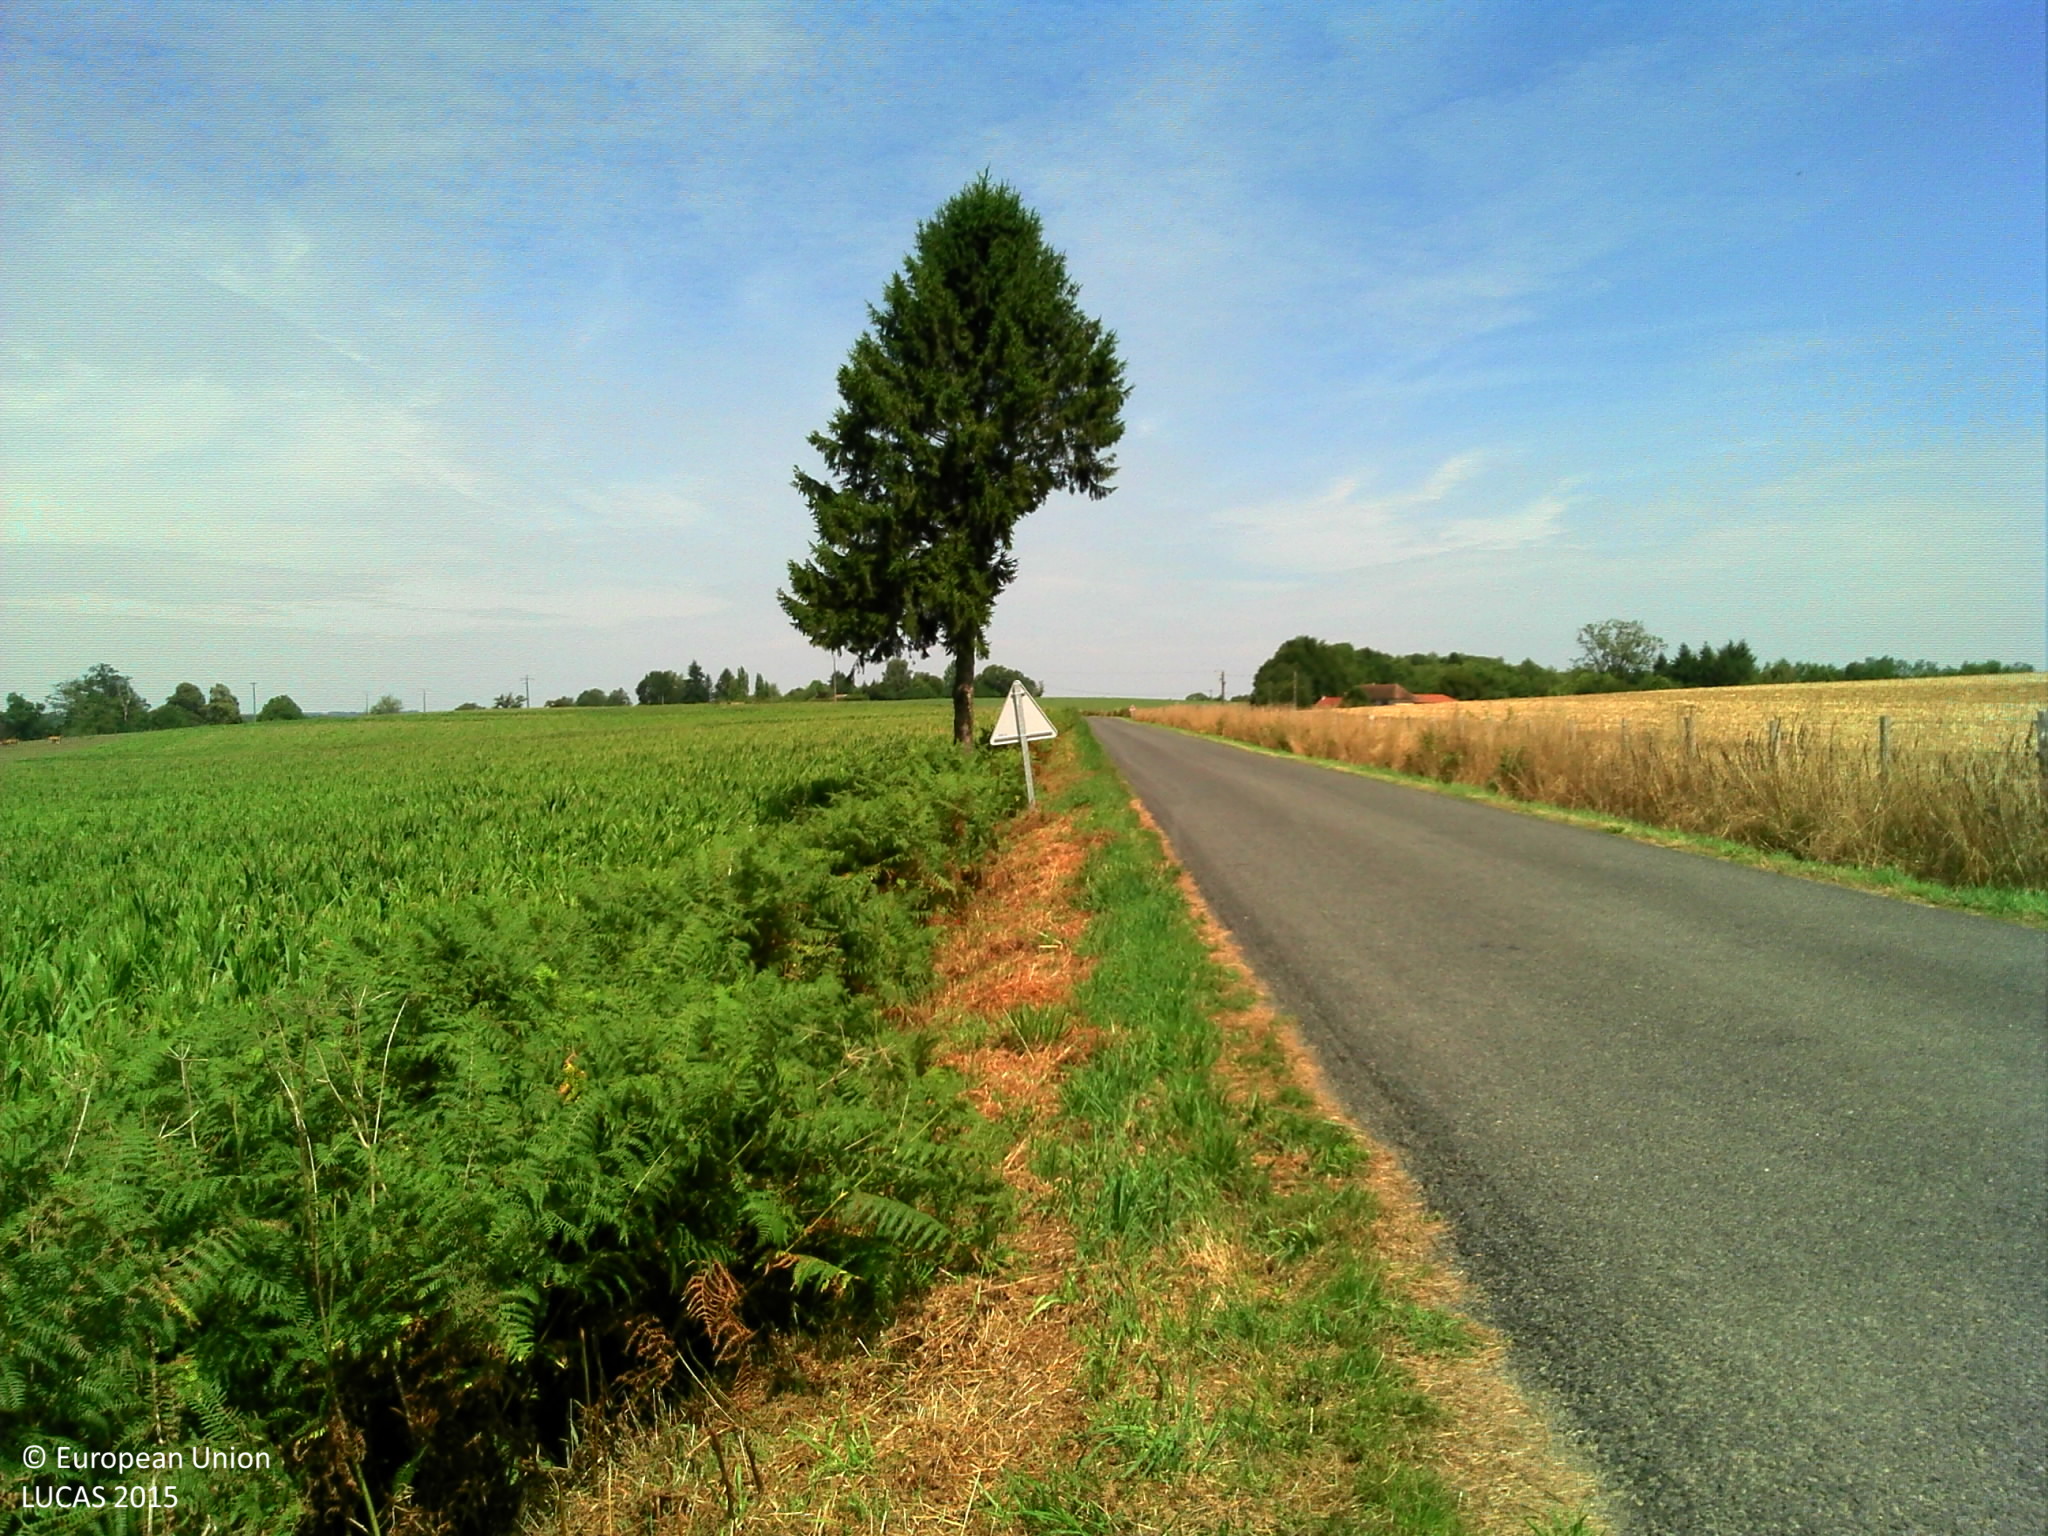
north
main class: Cropland
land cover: Maize
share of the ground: > 75 %
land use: Agriculture (excluding fallow land and kitchen gardens)
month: August
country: FR
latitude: 45.6345
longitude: 1.3072
